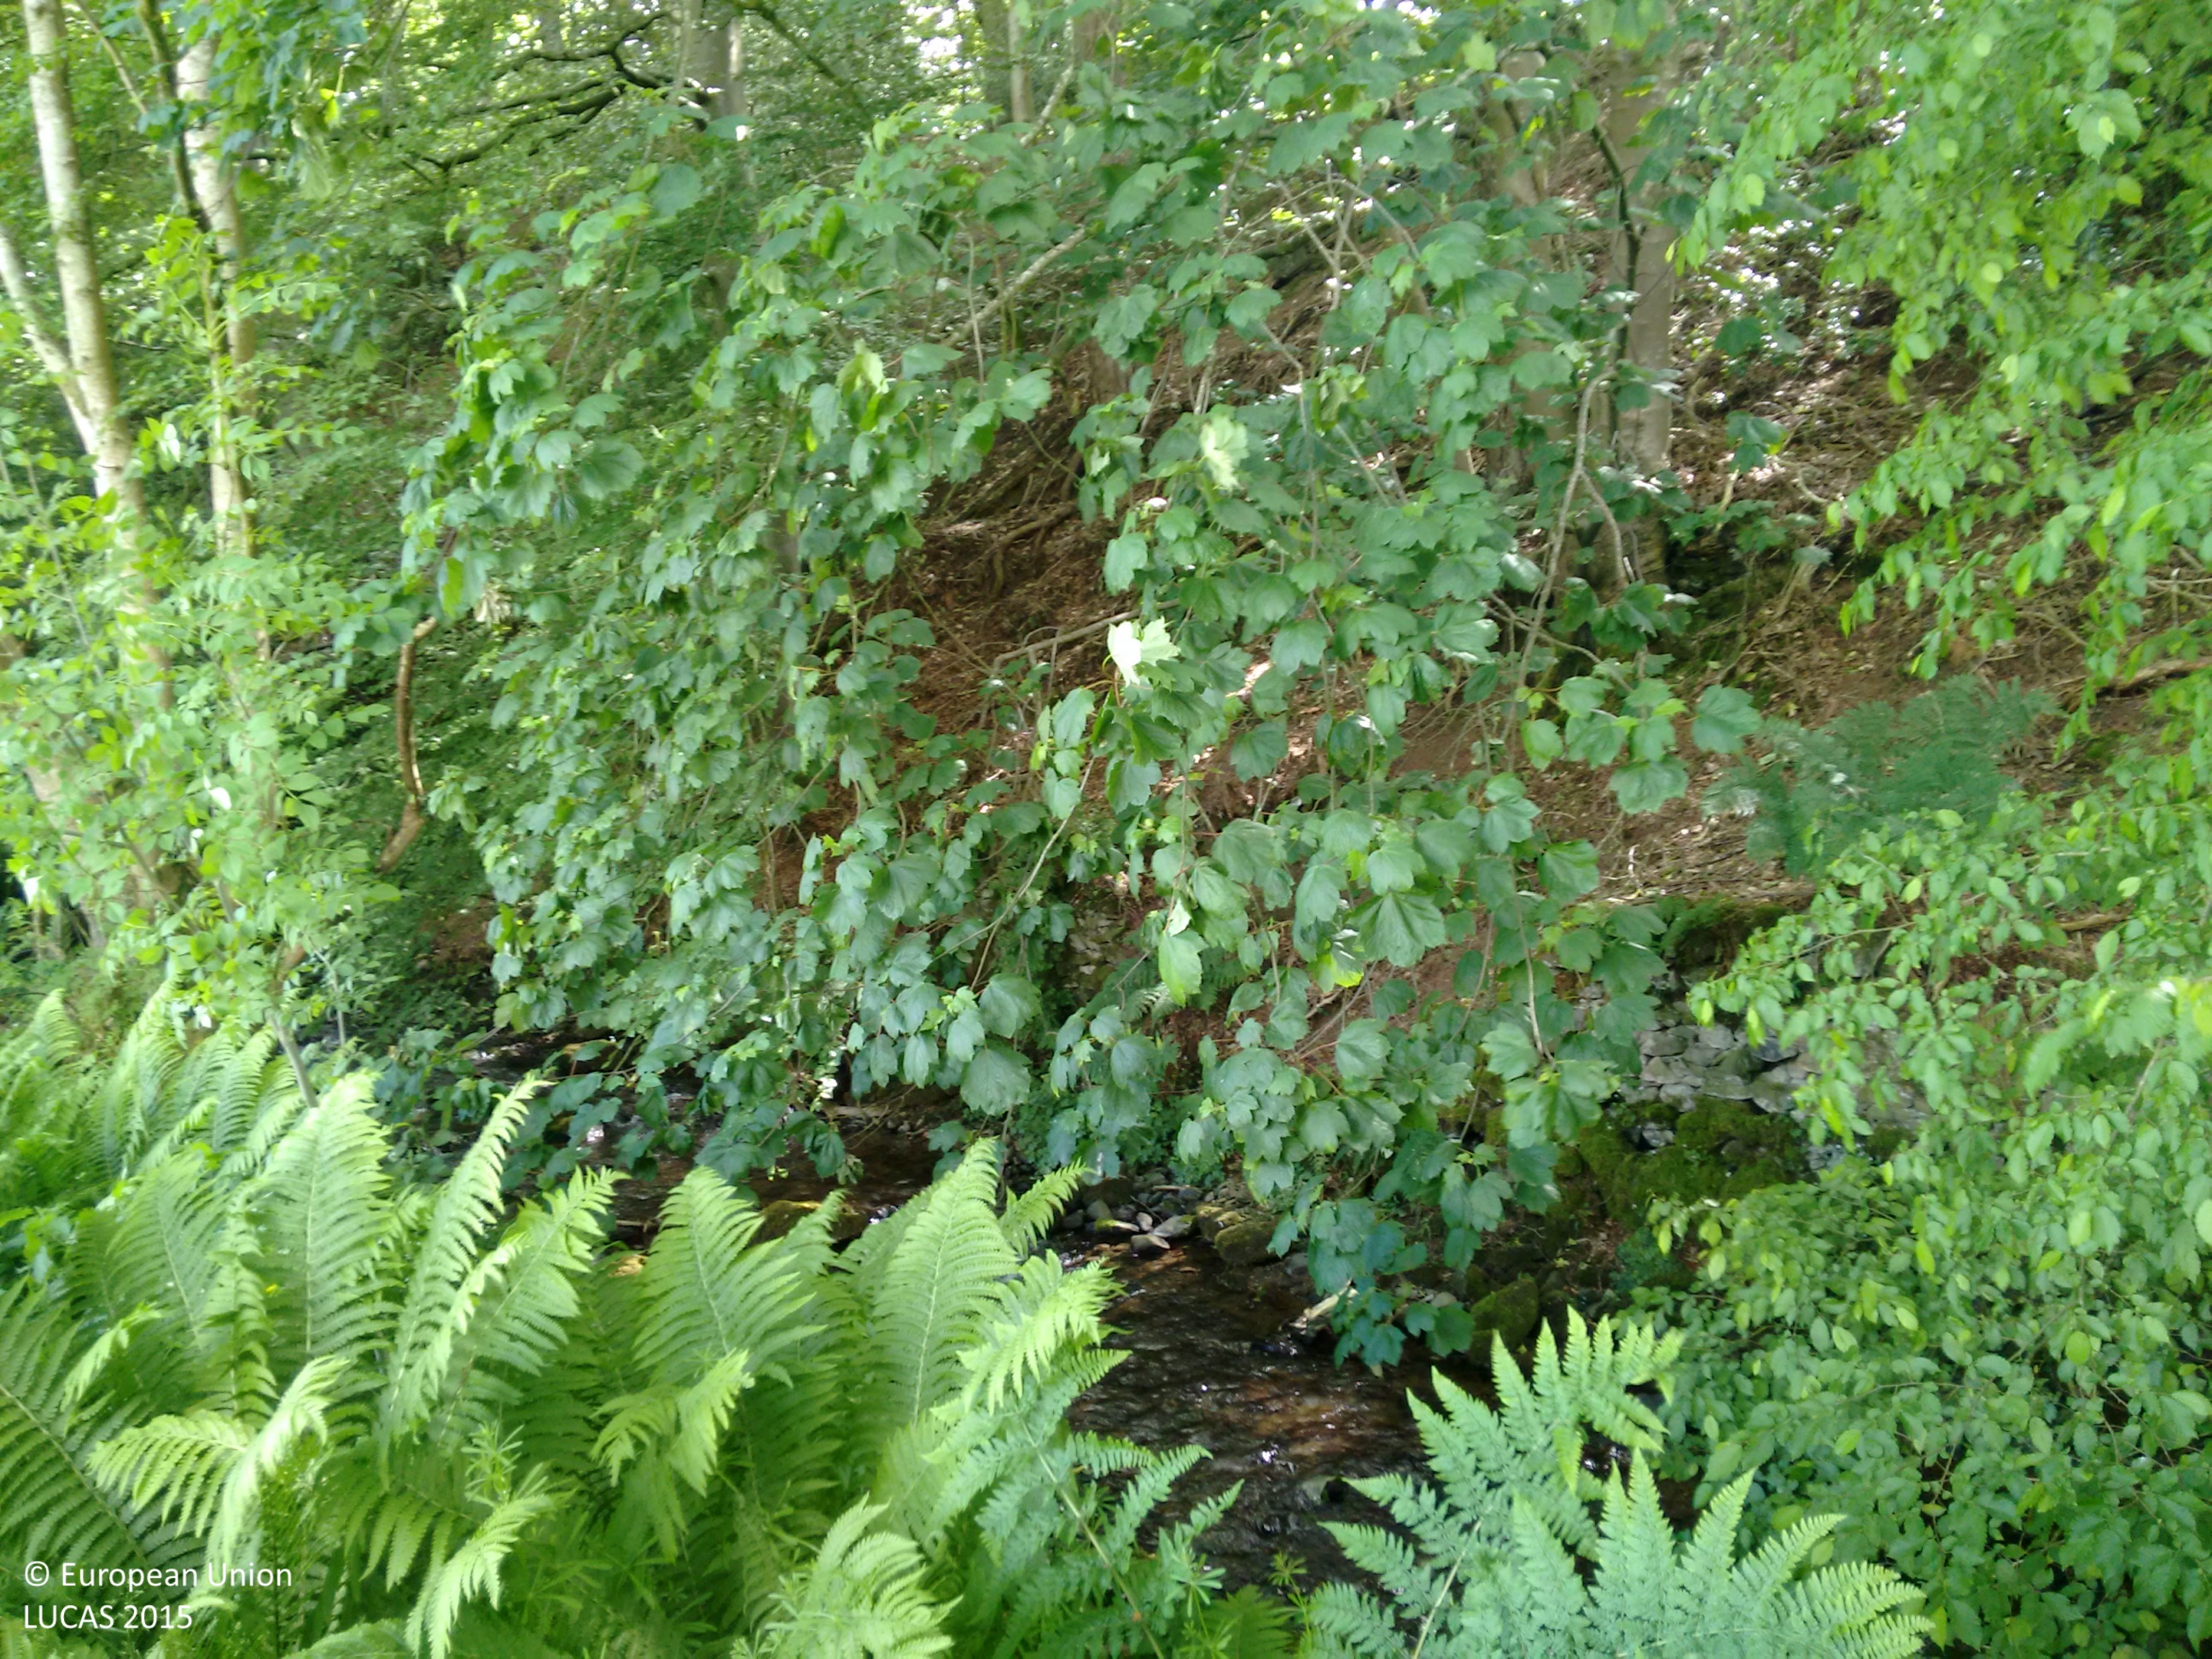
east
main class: Woodland
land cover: Broadleaved woodland
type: floodplain forest
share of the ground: > 75 %
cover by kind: broadleaved forest trees 90 %, shrubs 5 %, herbaceous plants 5 %
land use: Semi-natural and natural areas not in use
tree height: > 5 m
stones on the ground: < 10 %
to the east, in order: Broadleaved woodland; Rivers and streams; Broadleaved woodland; Artificial constructions in urban areas; Broadleaved woodland; Artificial constructions in urban areas; Broadleaved woodland; Fences; Grassland without tree/shrub cover
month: June
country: GB
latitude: 55.3153
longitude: -3.7458
